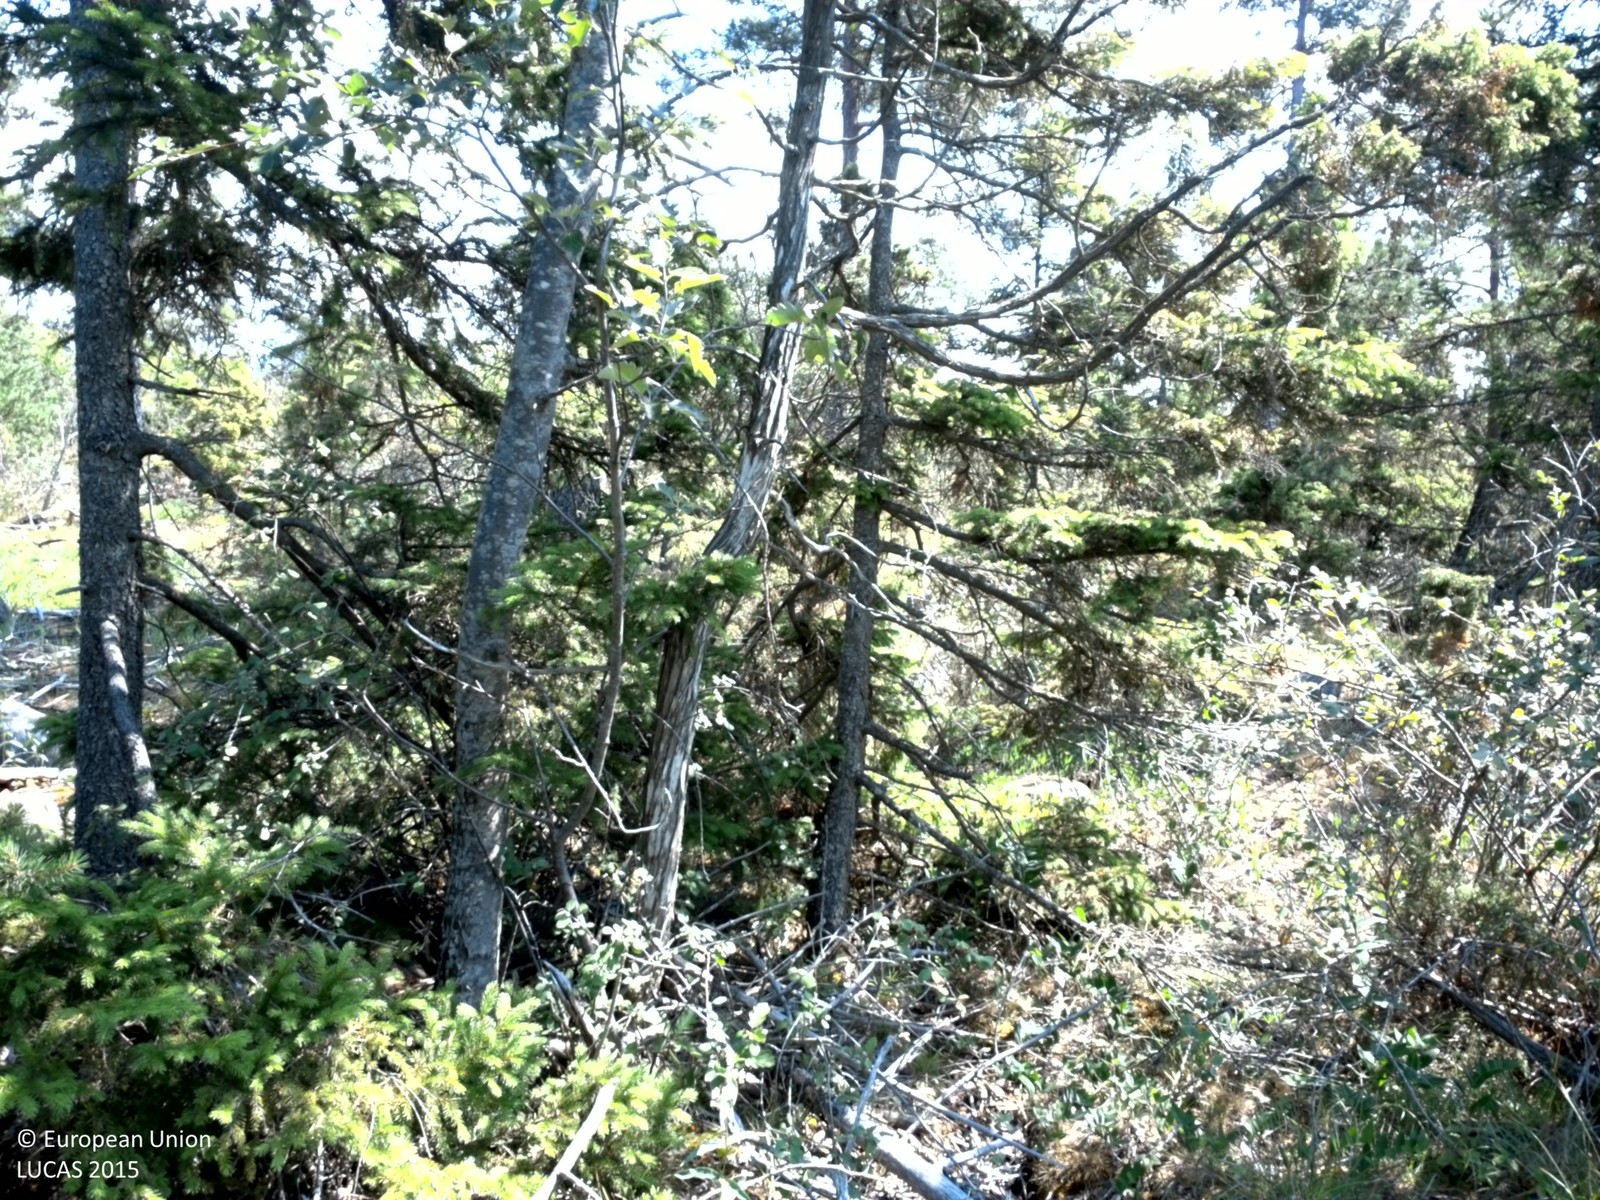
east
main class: Woodland
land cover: Pine dominated coniferous woodland
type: hemiboreal forest and nemoral coniferous forest and mixed broadleaved-coniferous forest
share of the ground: 50 - 75 %
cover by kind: coniferous forest trees 50 %, herbaceous plants 30 %, shrubs 10 %, broadleaved forest trees 5 %, consolidated bare surface 5 %
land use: Forestry
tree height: > 5 m
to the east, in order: Pine dominated coniferous woodland; Lichens and moss; Shrubland with sparse tree cover; Lichens and moss; Shrubland with sparse tree cover
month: July
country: SE
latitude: 57.3597
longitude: 18.6711
